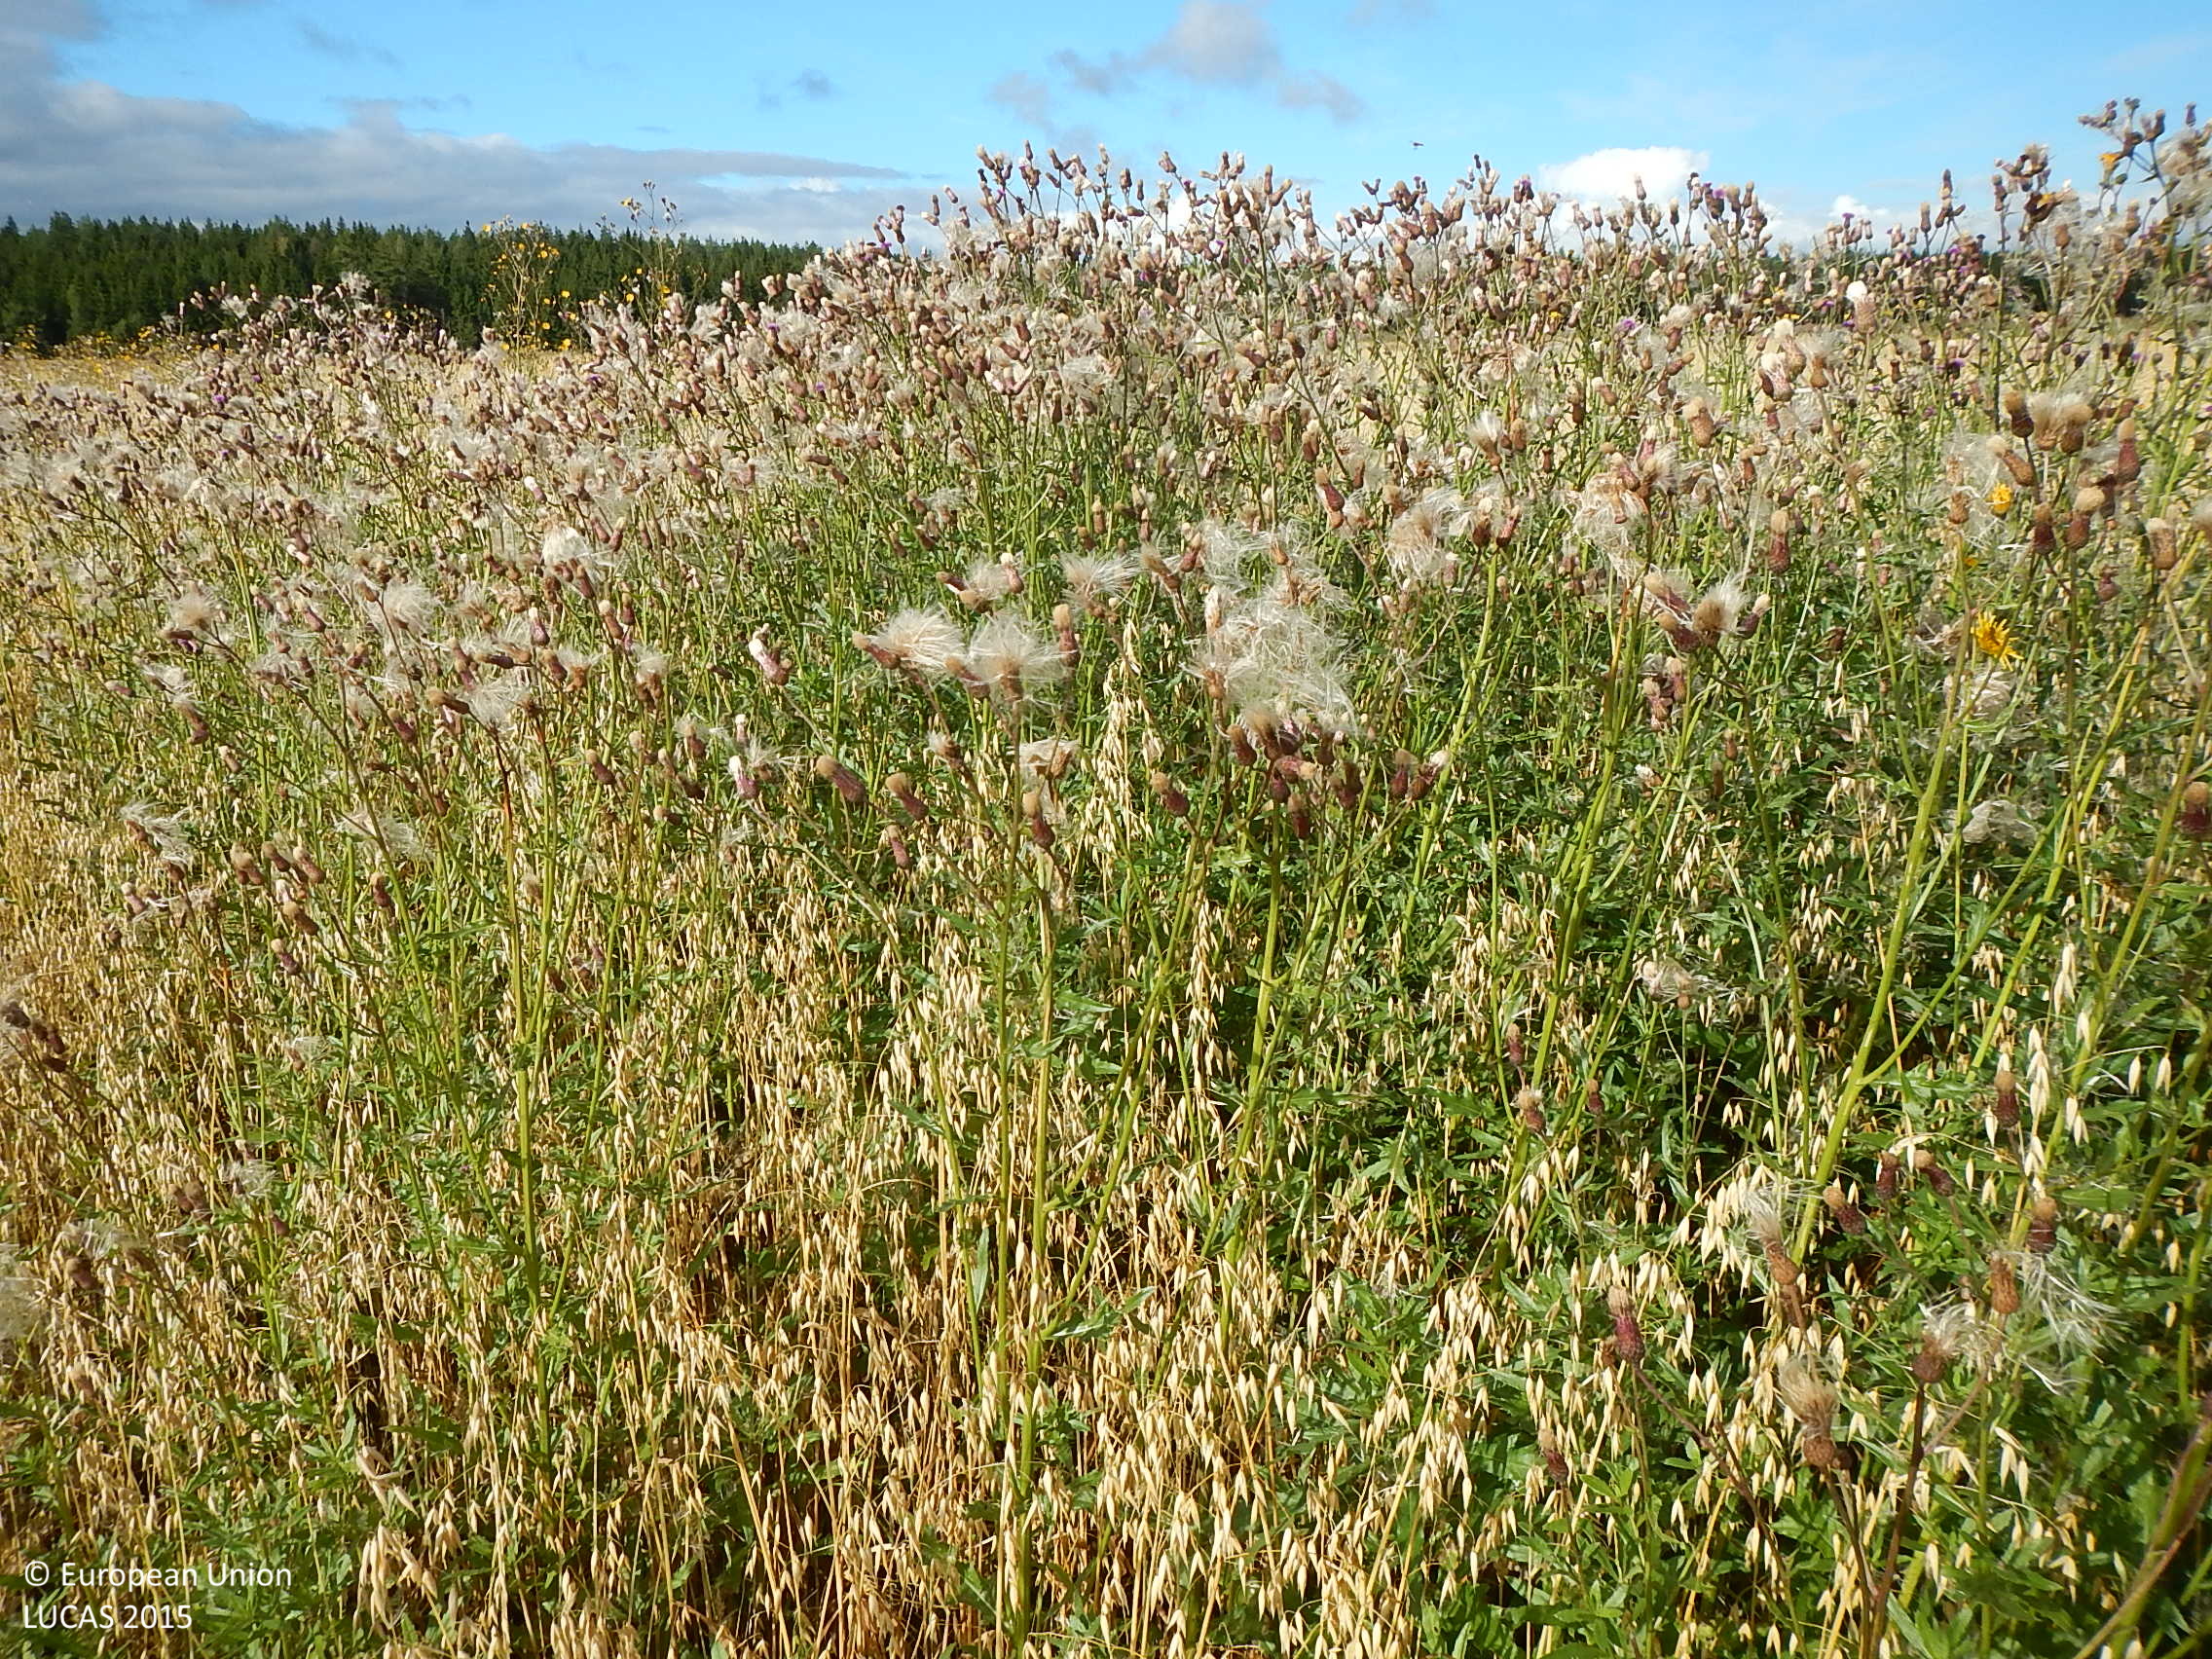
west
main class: Cropland
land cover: Oats
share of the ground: > 75 %
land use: Agriculture (excluding fallow land and kitchen gardens)
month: September
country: FI
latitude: 61.4156
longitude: 22.0299
